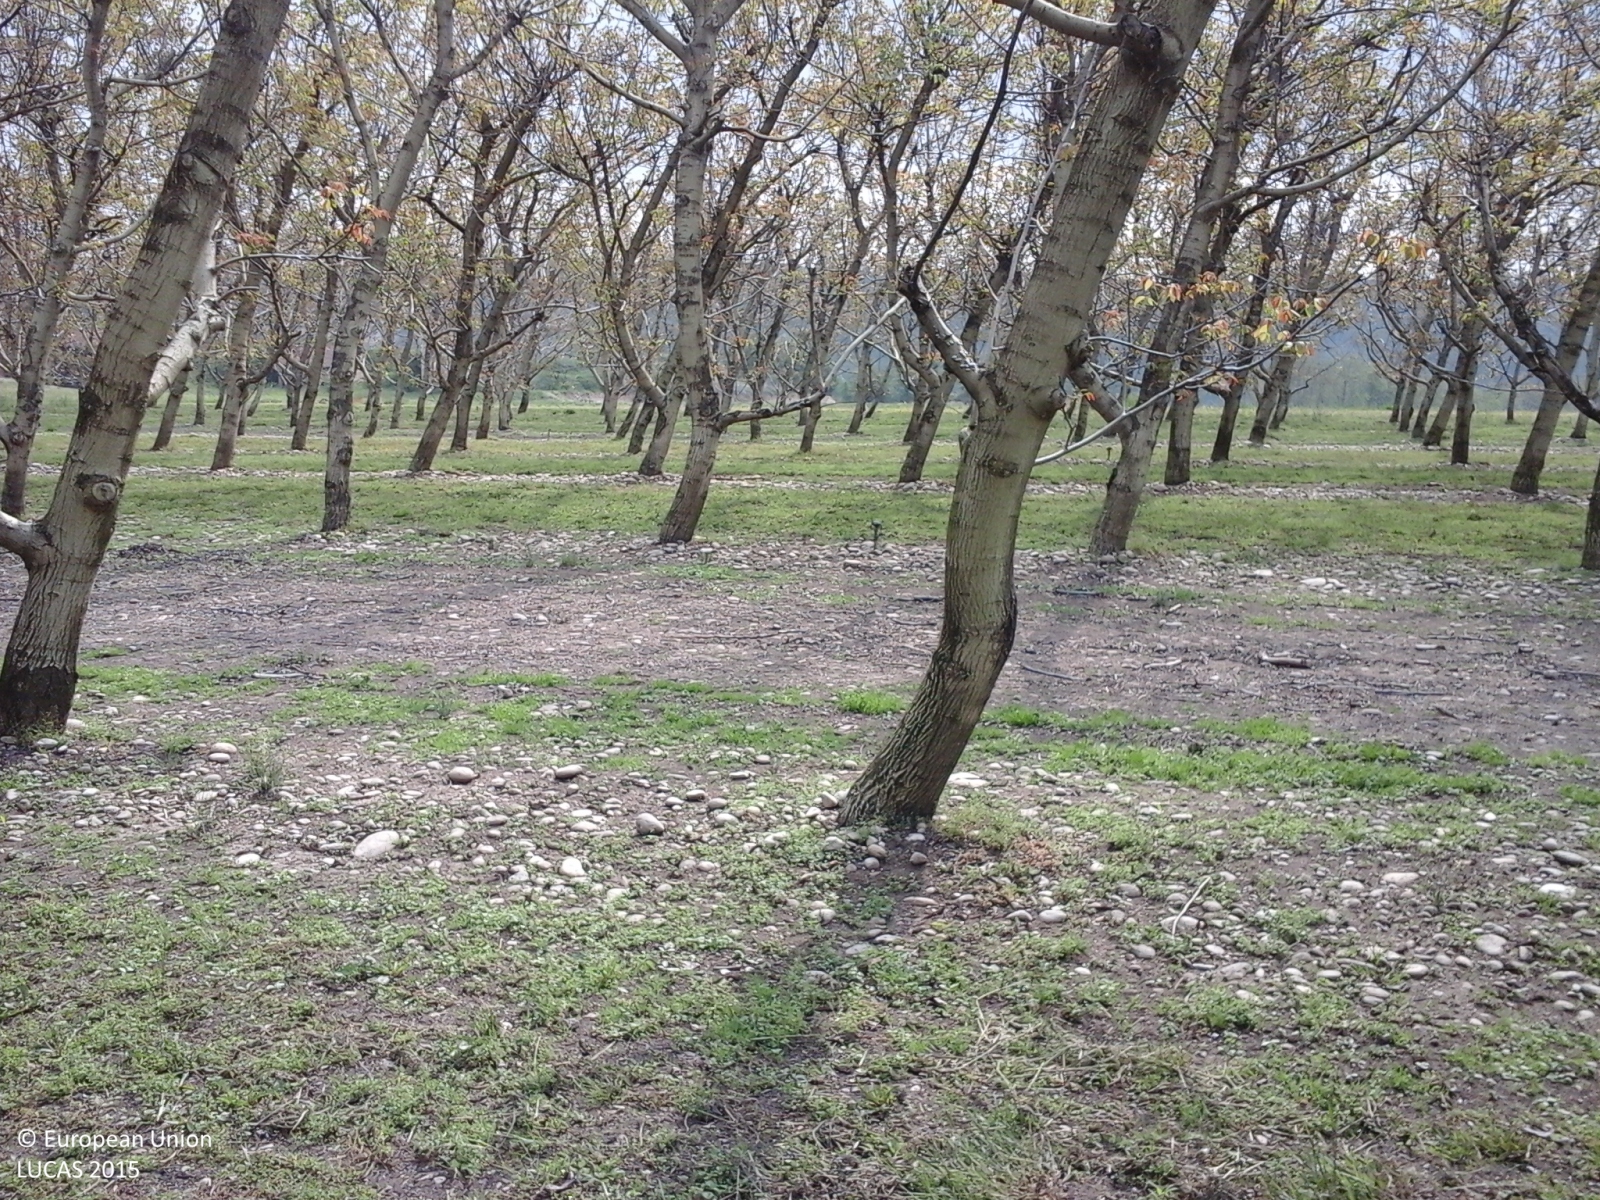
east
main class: Cropland
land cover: Nuts trees
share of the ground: 50 - 75 %
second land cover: Grassland without tree/shrub cover
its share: 50 - 75 %
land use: Agriculture (excluding fallow land and kitchen gardens)
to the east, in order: Nuts trees; Grassland without tree/shrub cover; Paved roads, cycling and walking lanes; Lucerne; Barley; Lucerne; Paved roads, cycling and walking lanes; Other bare soil; Broadleaved woodland
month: May
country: IT
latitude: 44.5973
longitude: 7.7747
